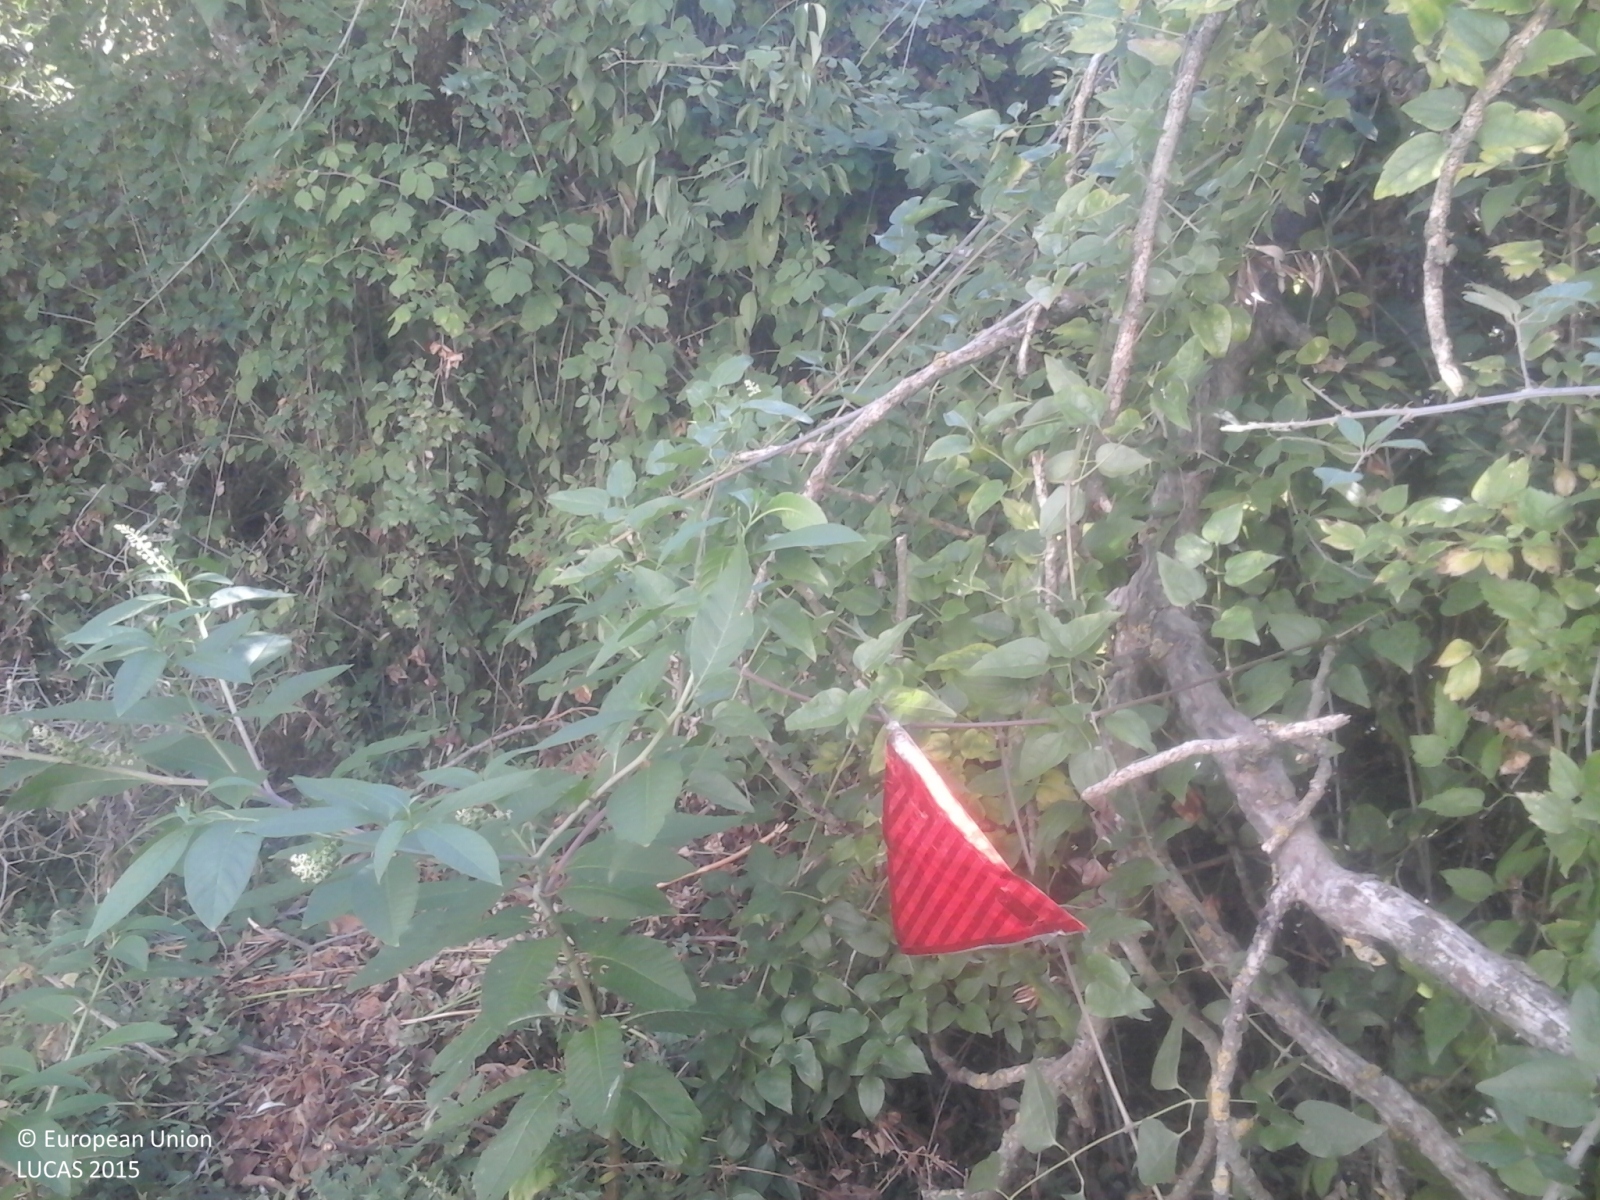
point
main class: Cropland
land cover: Other fruit trees and berries
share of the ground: 25 - 50 %
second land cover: Shrubland without tree cover
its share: > 75 %
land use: Abandoned areas
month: August
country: IT
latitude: 42.5139
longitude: 12.5355
